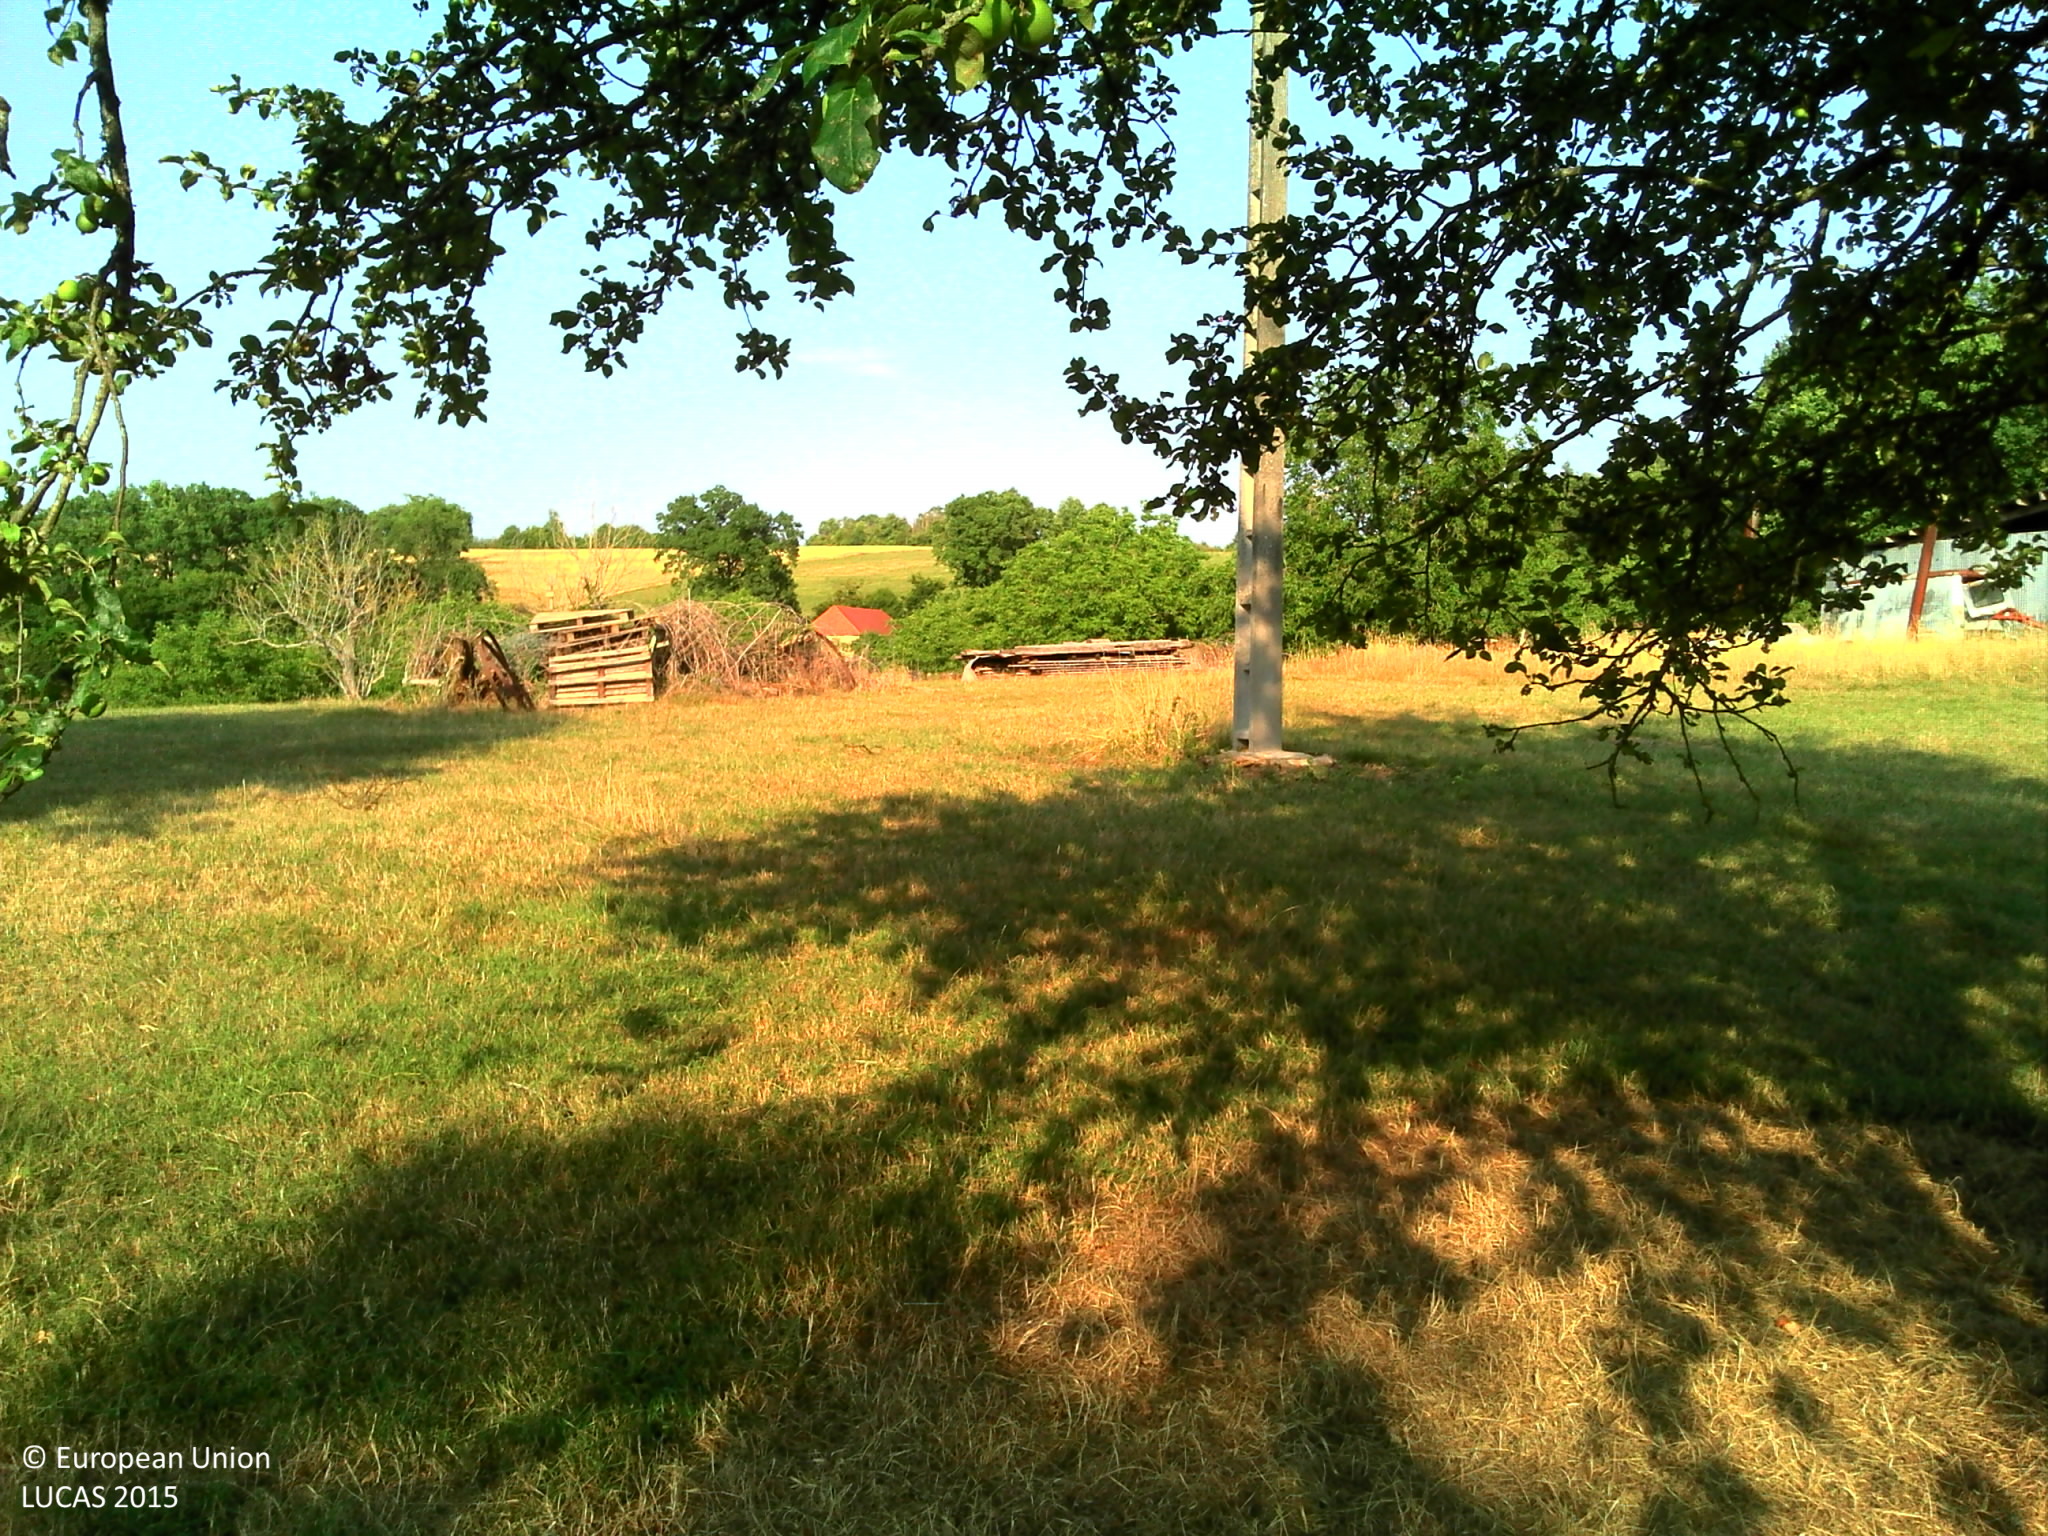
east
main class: Cropland
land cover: Apple fruit
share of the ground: 25 - 50 %
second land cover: Grassland without tree/shrub cover
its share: 50 - 75 %
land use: Agriculture (excluding fallow land and kitchen gardens)
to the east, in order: Apple fruit; Grassland without tree/shrub cover; Electric lines; Grassland without tree/shrub cover; Artificial constructions; Grassland with sparse tree/shrub cover; Tracks; Grassland without tree/shrub cover; Fences; Grassland without tree/shrub cover; Artificial constructions in urban areas
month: July
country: FR
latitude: 45.3272
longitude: 1.0992
